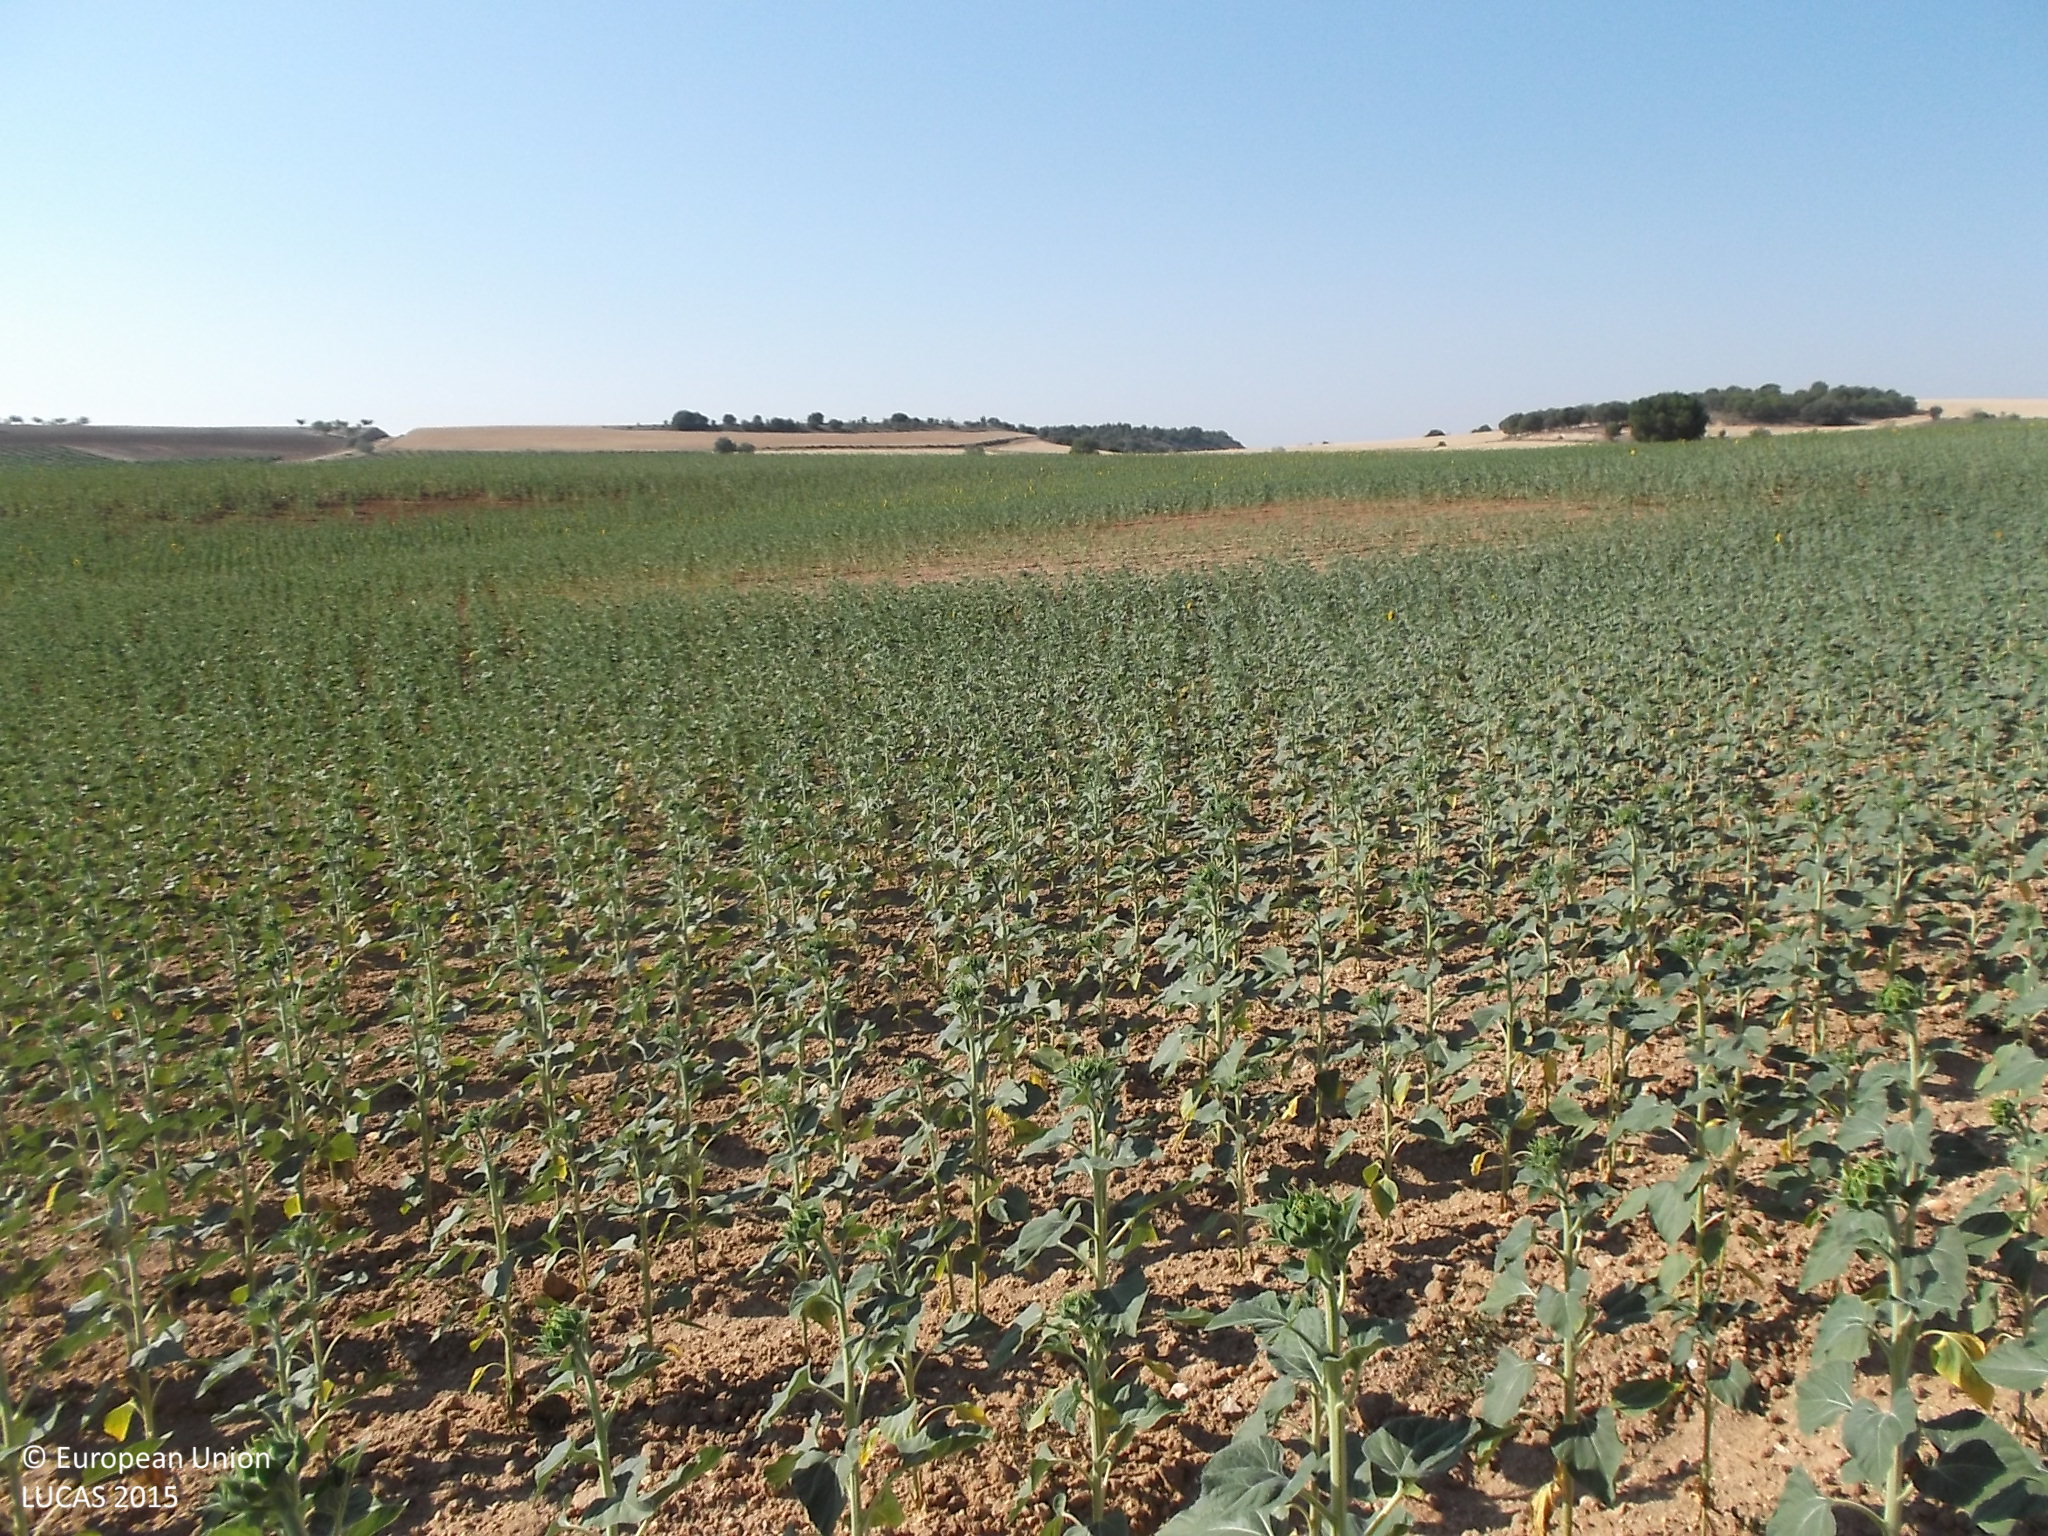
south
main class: Cropland
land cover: Sunflower
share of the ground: > 75 %
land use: Agriculture (excluding fallow land and kitchen gardens)
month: July
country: ES
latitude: 41.4125
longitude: -5.4035
